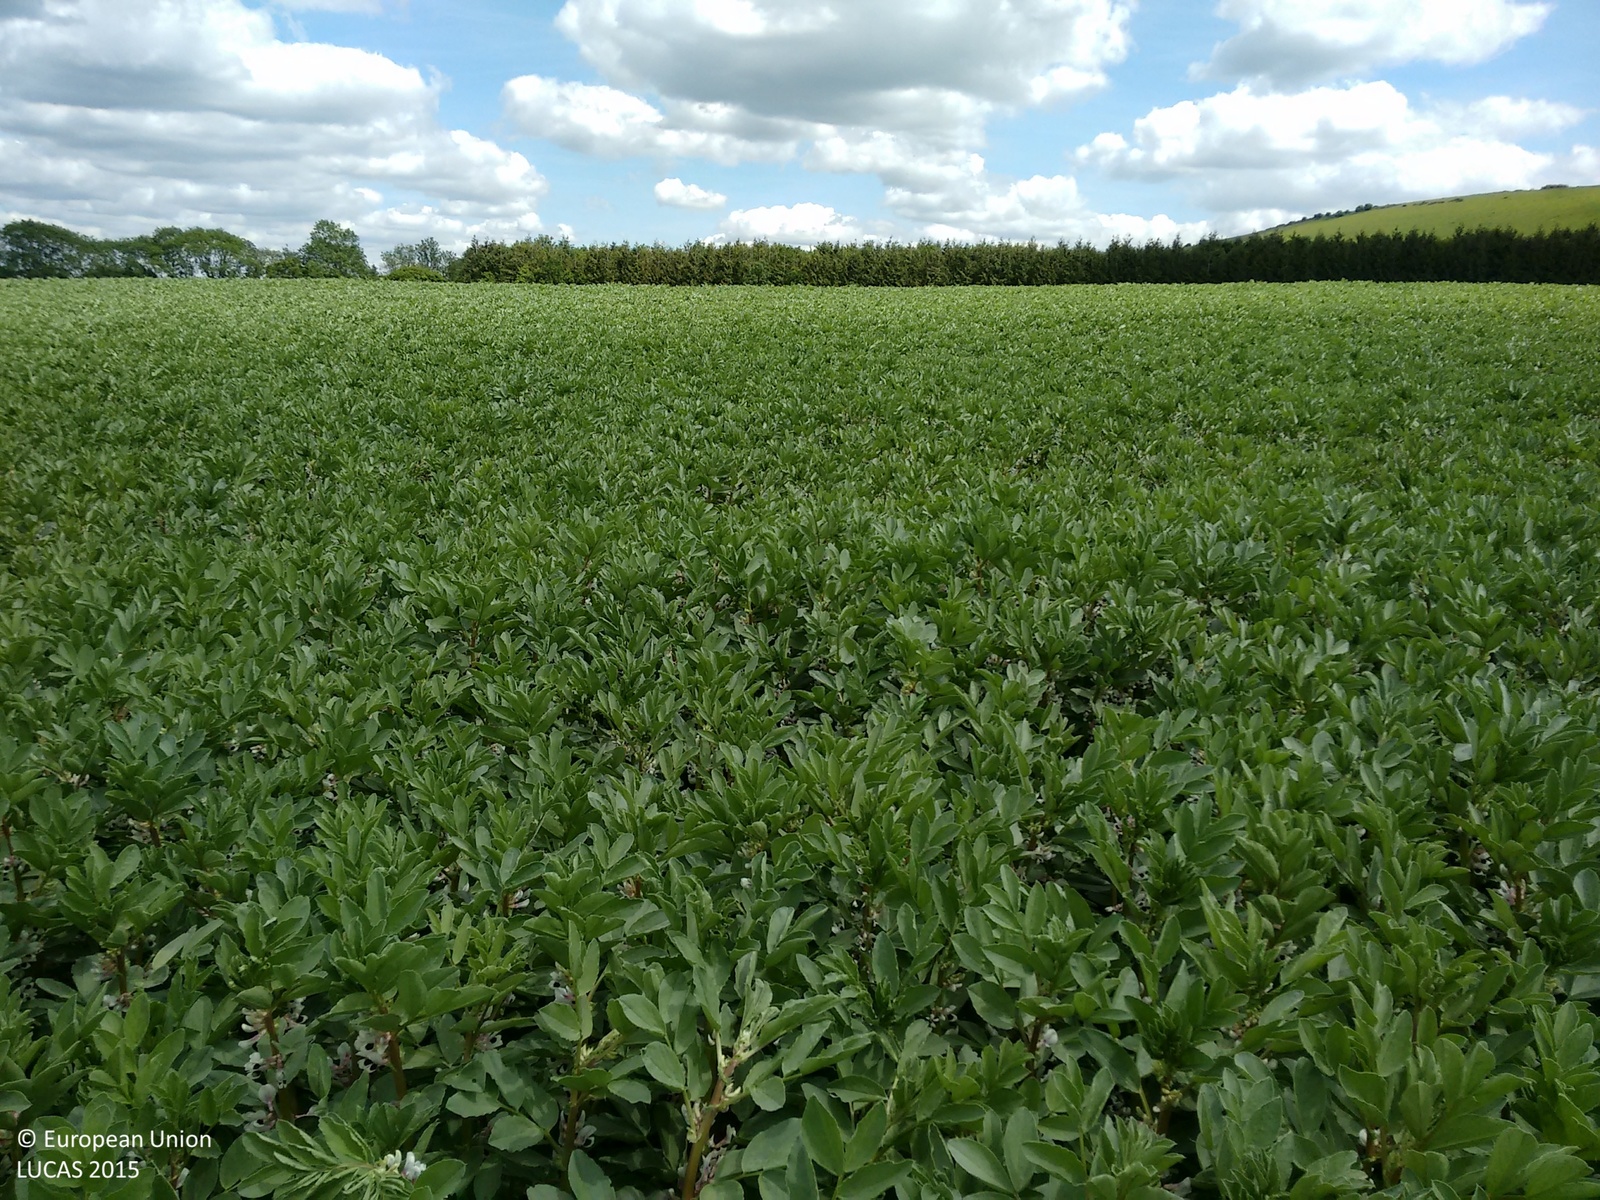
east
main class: Cropland
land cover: Dry pulses
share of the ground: > 75 %
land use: Agriculture (excluding fallow land and kitchen gardens)
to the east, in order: Dry pulses; Other bare soil; Tracks; Other coniferous woodland
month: June
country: GB
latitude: 51.3625
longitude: -1.4978
